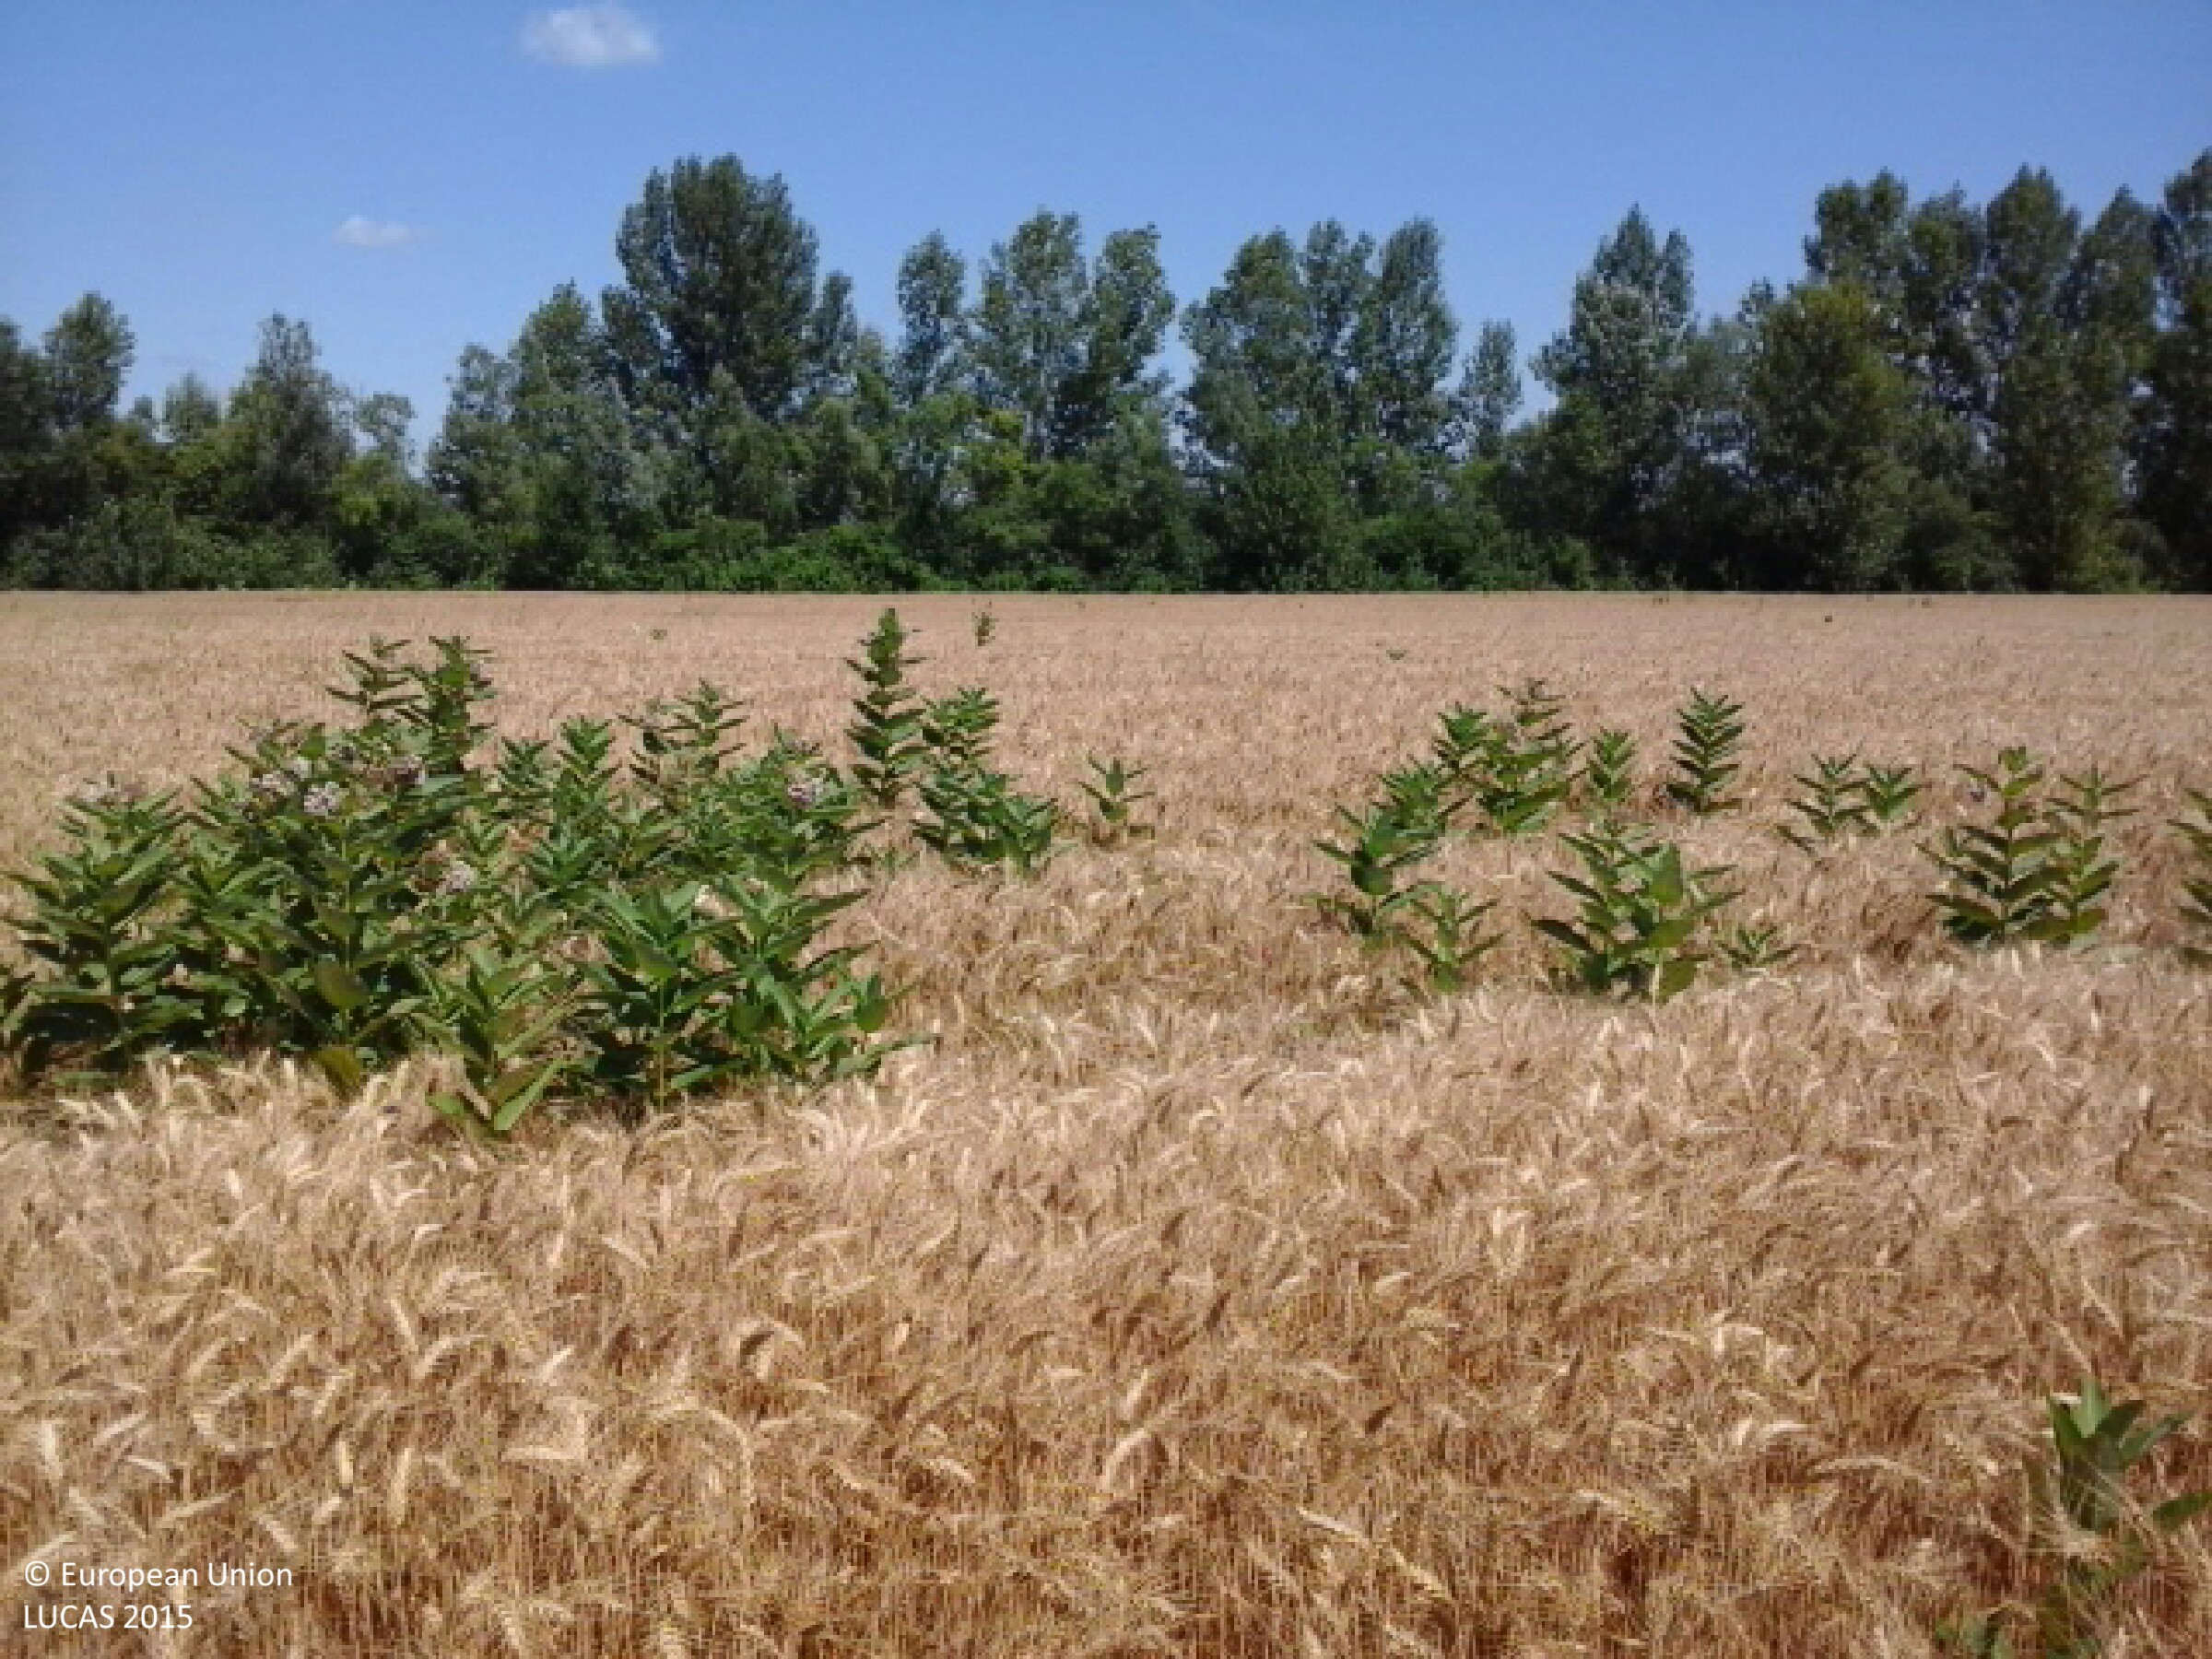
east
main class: Cropland
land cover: Durum wheat
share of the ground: > 75 %
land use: Agriculture (excluding fallow land and kitchen gardens)
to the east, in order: Durum wheat; Shruby margins; Broadleaved woodland; Ditches and canals; Tracks; Ditches and canals; Broadleaved woodland; Maize; Grass margins; Tracks
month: July
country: HU
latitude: 47.9257
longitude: 22.3563
